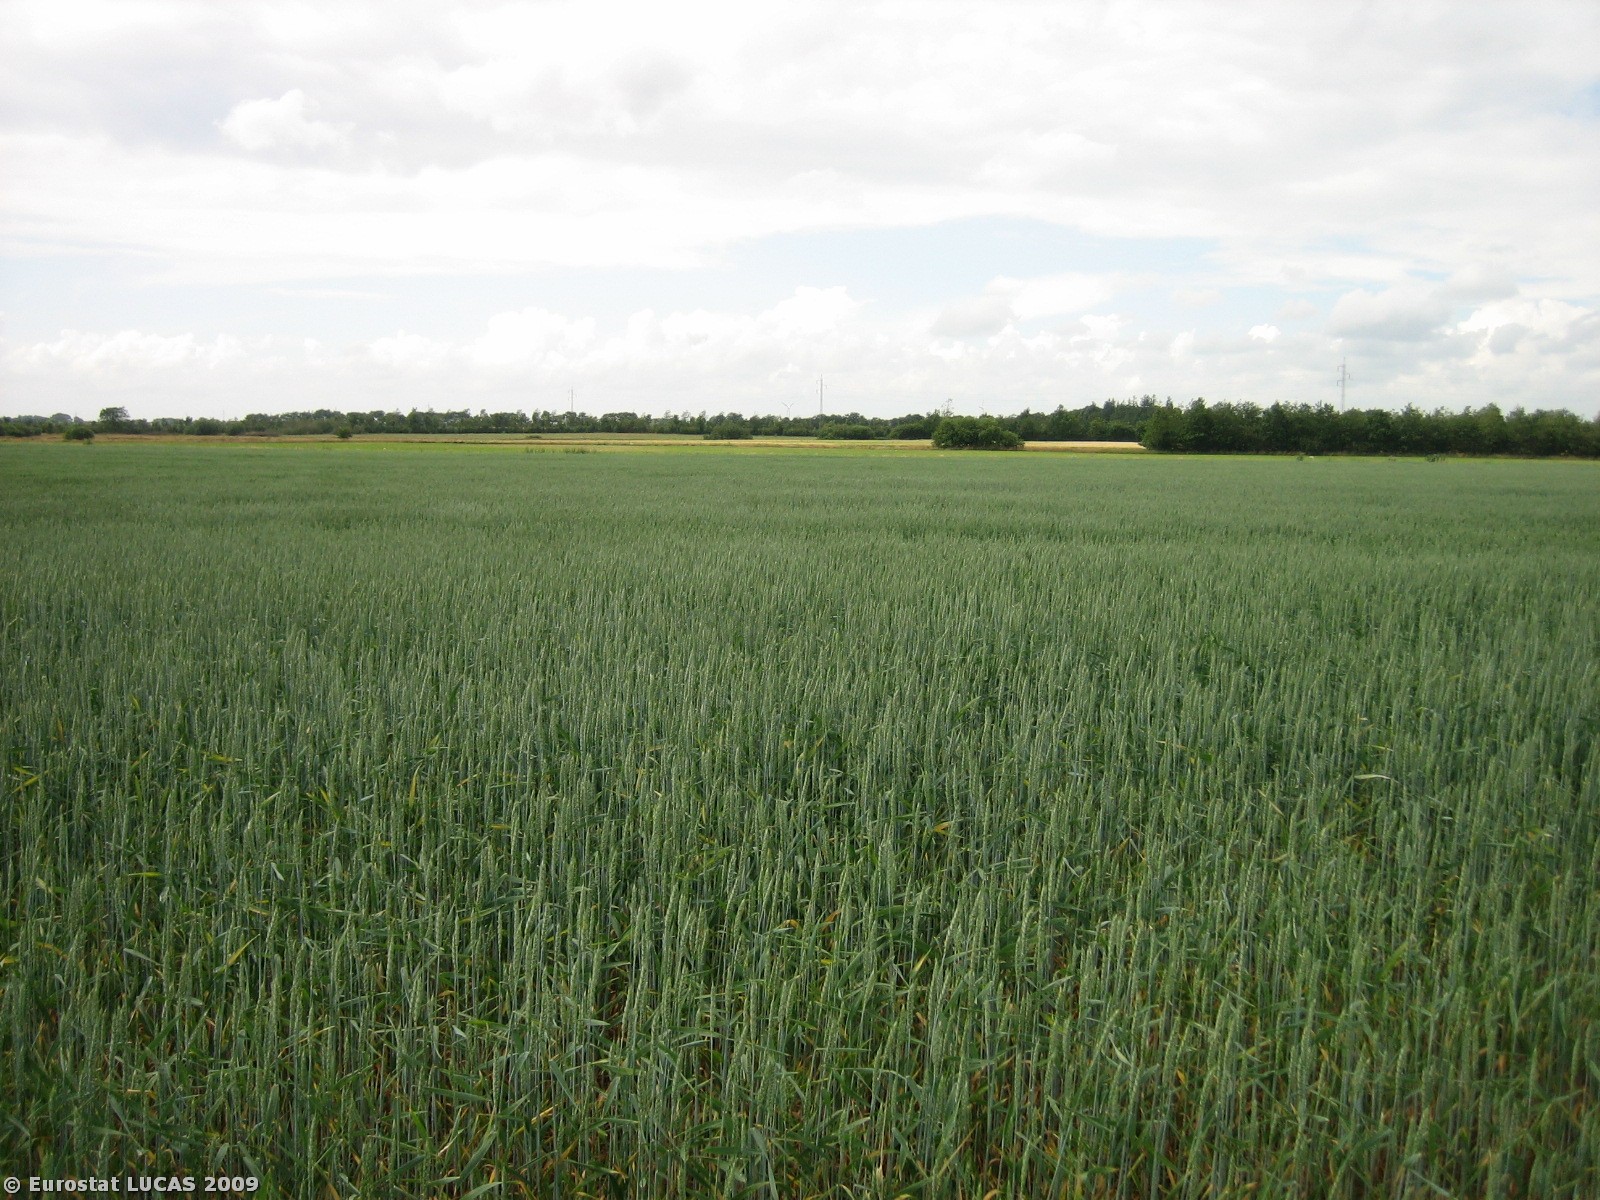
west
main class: Cropland
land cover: Triticale
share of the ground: > 75 %
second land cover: Spontaneously vegetated surfaces
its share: 50 - 75 %
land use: Agriculture (excluding fallow land and kitchen gardens)
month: July
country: DK
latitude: 55.6076
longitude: 8.8740
